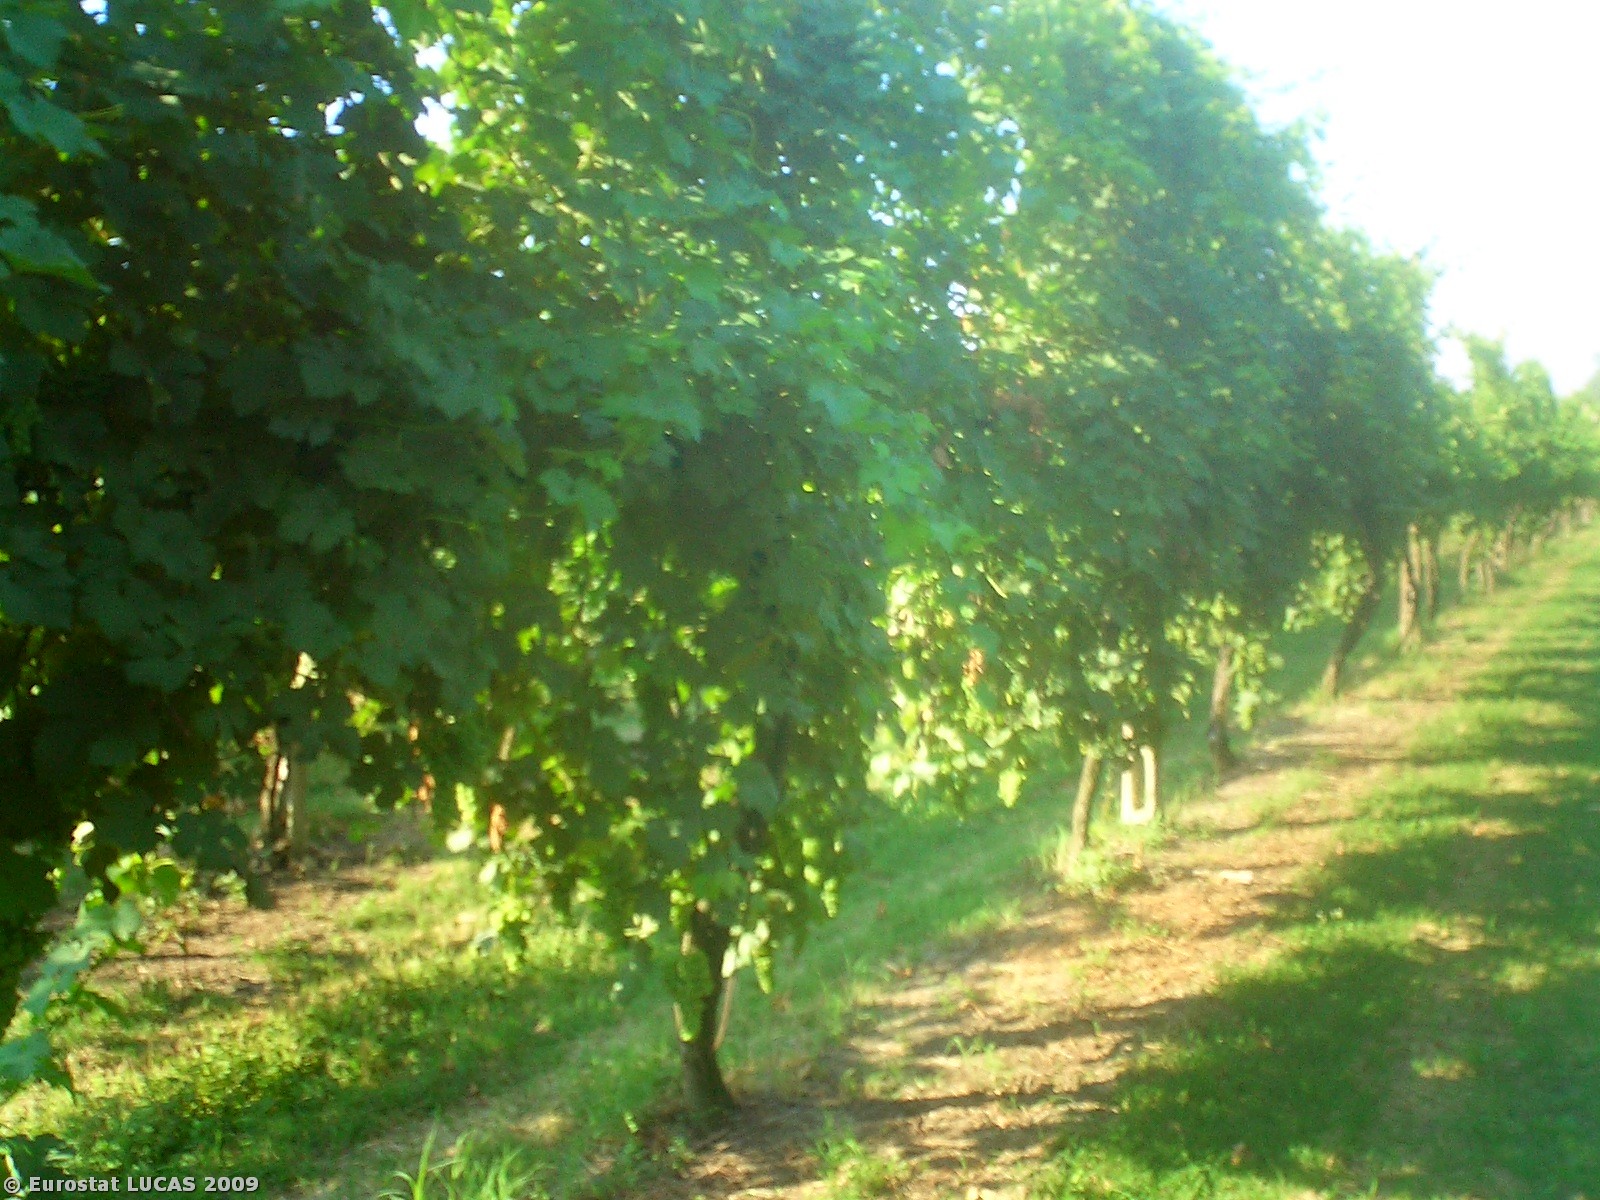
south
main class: Cropland
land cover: Vineyards
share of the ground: 50 - 75 %
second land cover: Grassland with sparse tree/shrub cover
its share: 50 - 75 %
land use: Agriculture (excluding fallow land and kitchen gardens)
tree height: < 5 m
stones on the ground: < 10 %
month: July
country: IT
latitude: 44.2959
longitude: 11.9634
